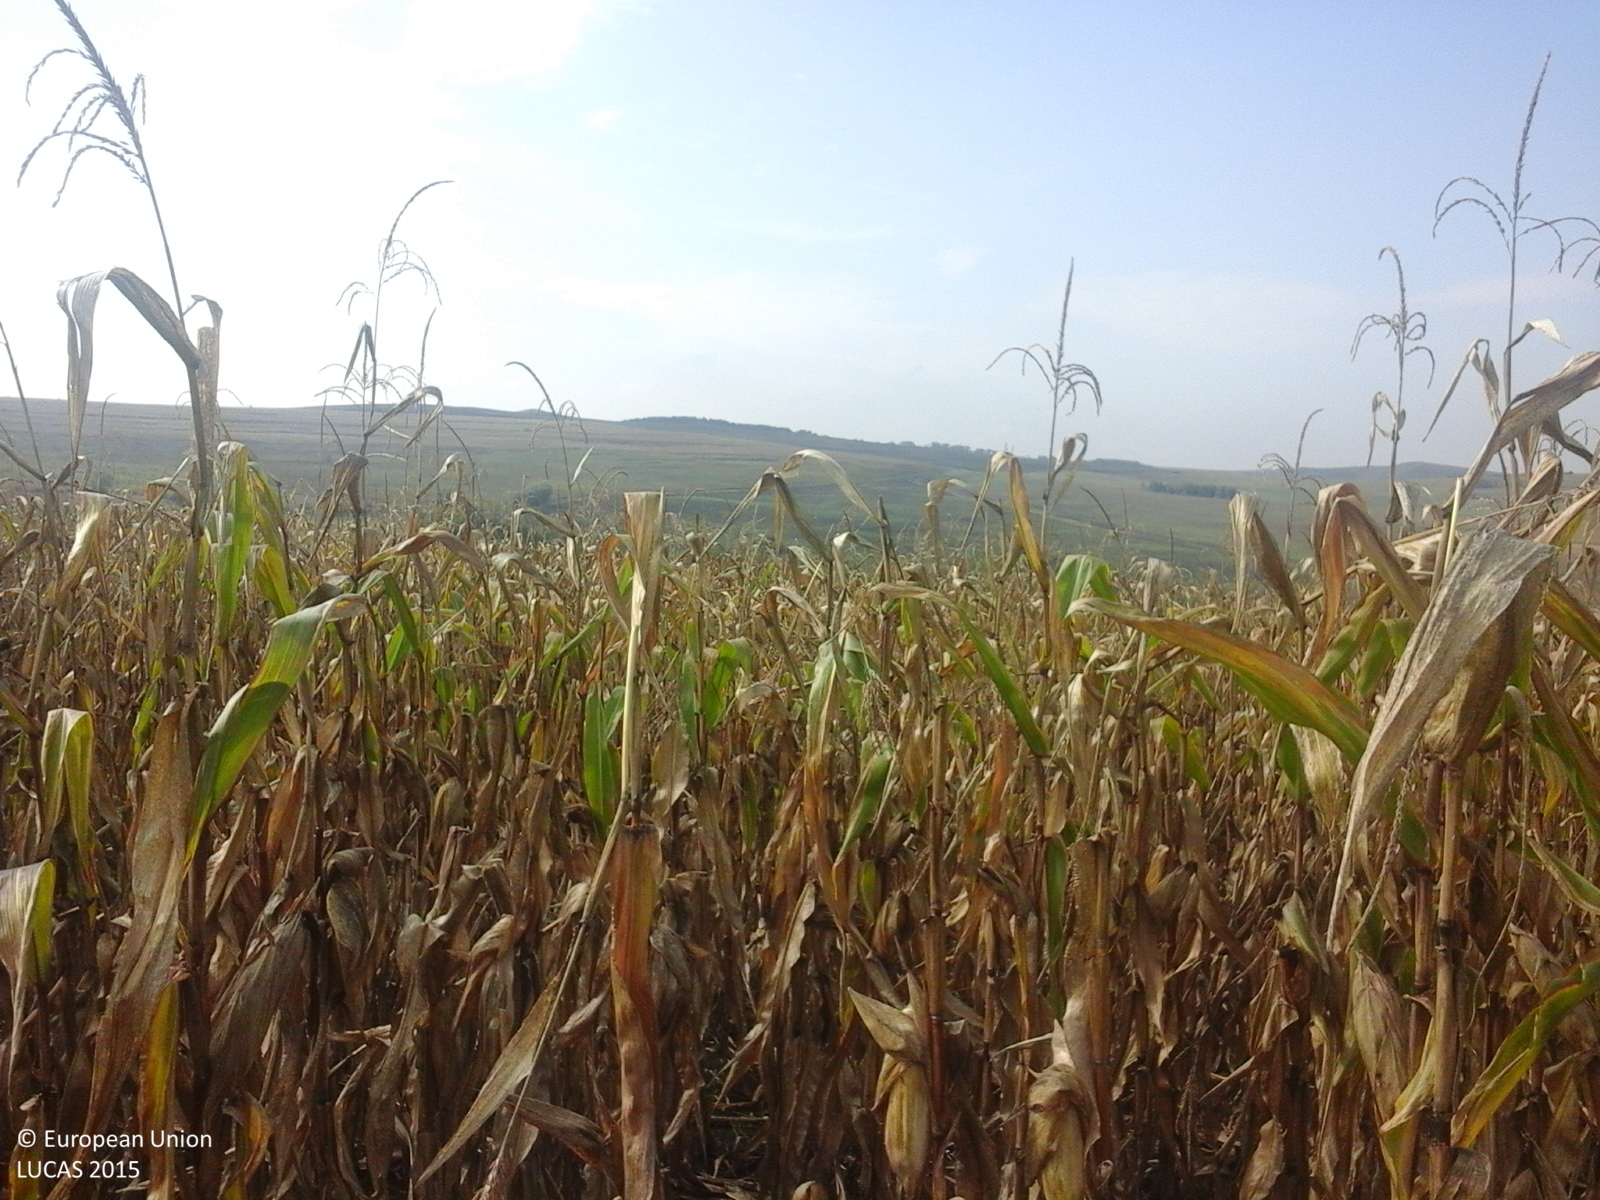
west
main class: Cropland
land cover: Maize
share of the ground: > 75 %
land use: Agriculture (excluding fallow land and kitchen gardens)
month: October
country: RO
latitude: 46.3692
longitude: 24.3162
